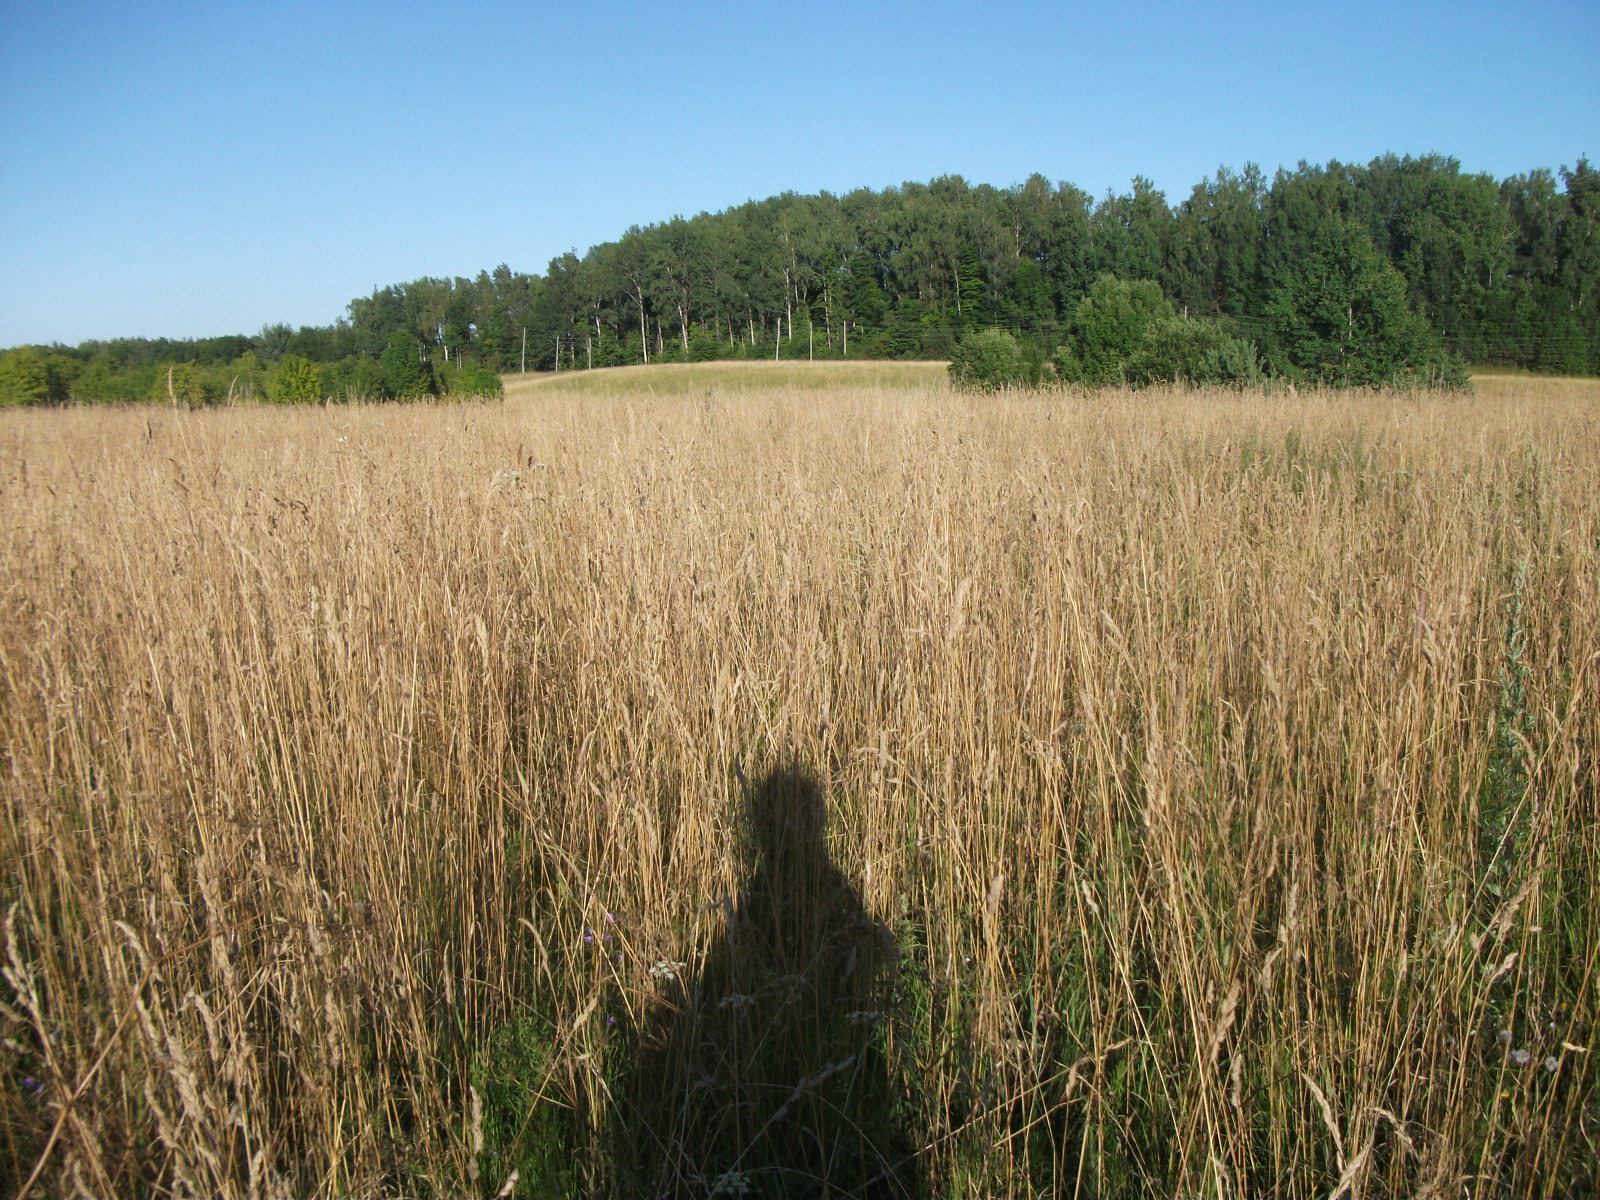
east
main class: Grassland
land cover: Grassland without tree/shrub cover
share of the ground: > 75 %
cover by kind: herbaceous plants 100 %
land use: Agriculture (excluding fallow land and kitchen gardens)
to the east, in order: Grassland without tree/shrub cover; Tracks; Grassland without tree/shrub cover
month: August
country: LV
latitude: 56.8726
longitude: 26.2332
